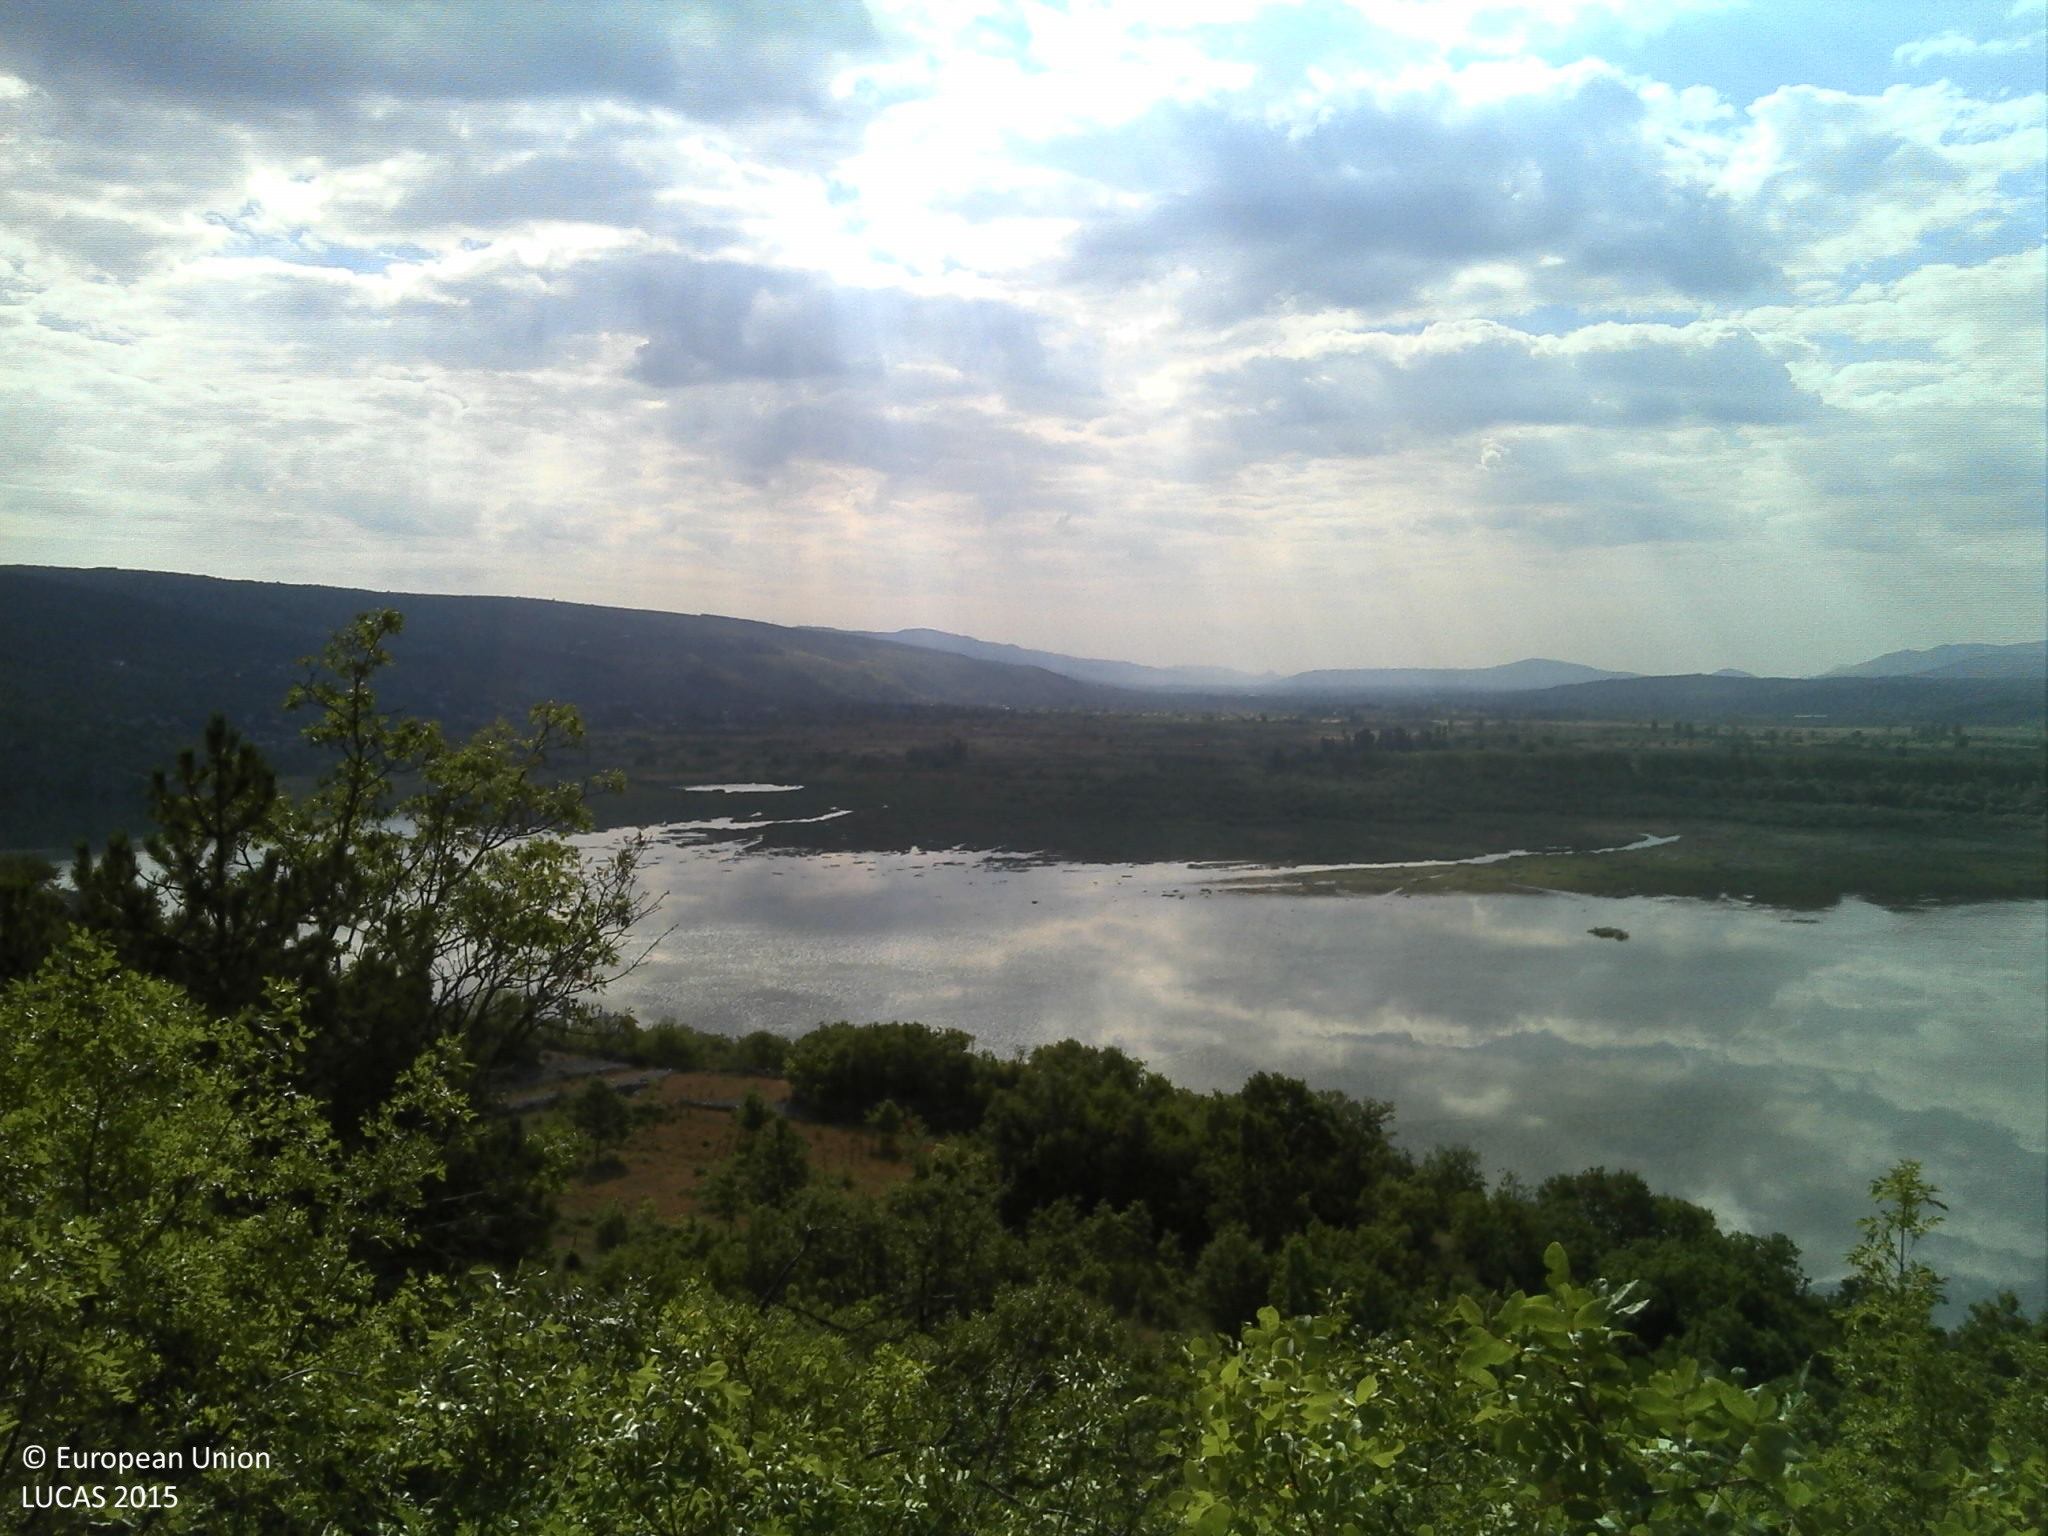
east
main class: Shrubland
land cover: Shrubland with sparse tree cover
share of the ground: 50 - 75 %
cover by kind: shrubs 60 %, consolidated bare surface 15 %, herbaceous plants 10 %, unconsolidated bare surface 10 %, broadleaved forest trees 5 %
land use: Semi-natural and natural areas not in use
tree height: < 5 m
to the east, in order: Shrubland with sparse tree cover; Tracks; Shrubland with sparse tree cover; Dry stone walls; Shrubland with sparse tree cover; Dry stone walls; Grassland with sparse tree/shrub cover; Dry stone walls; Grassland with sparse tree/shrub cover; Dry stone walls; Grassland with sparse tree/shrub cover; Dry stone walls; Shrubland with sparse tree cover; Dry stone walls; Shrubland with sparse tree cover; Dry stone walls; Shrubland with sparse tree cover
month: July
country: HR
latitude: 43.4735
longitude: 17.1000
